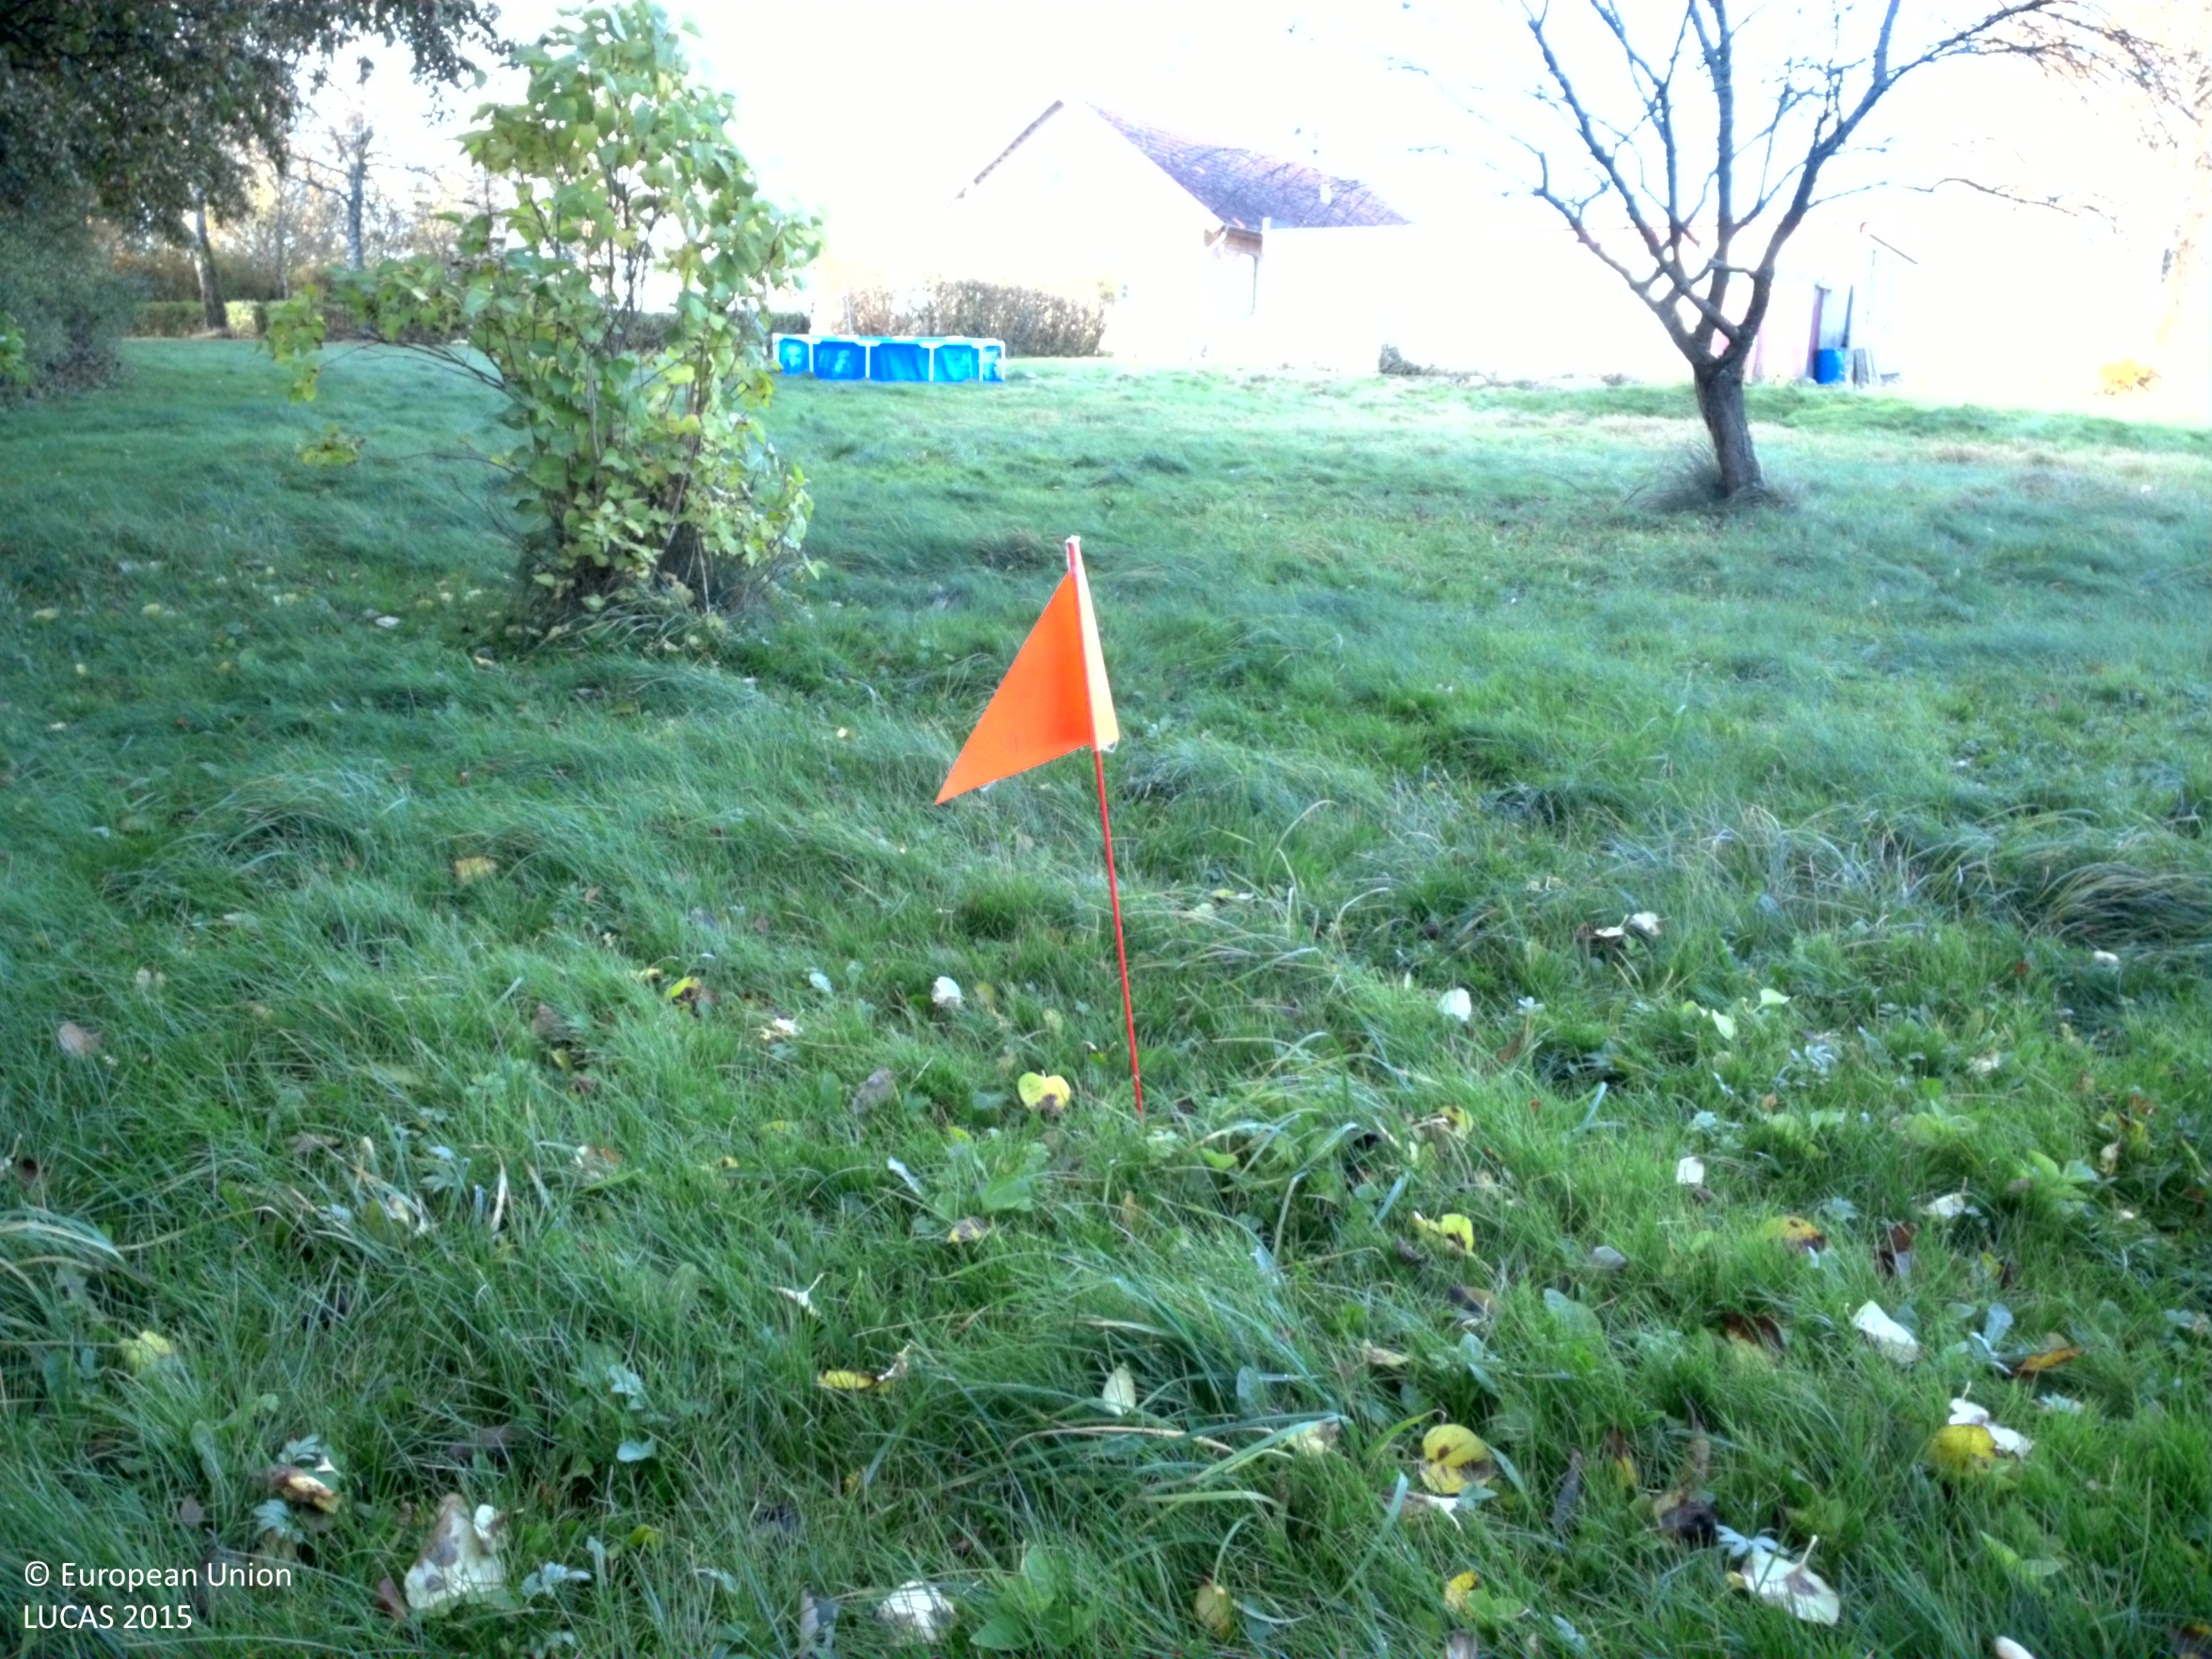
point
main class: Grassland
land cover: Grassland with sparse tree/shrub cover
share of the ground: > 75 %
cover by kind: herbaceous plants 95 %, broadleaved forest trees 5 %
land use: Residential
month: October
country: SE
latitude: 55.9348
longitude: 13.0872
